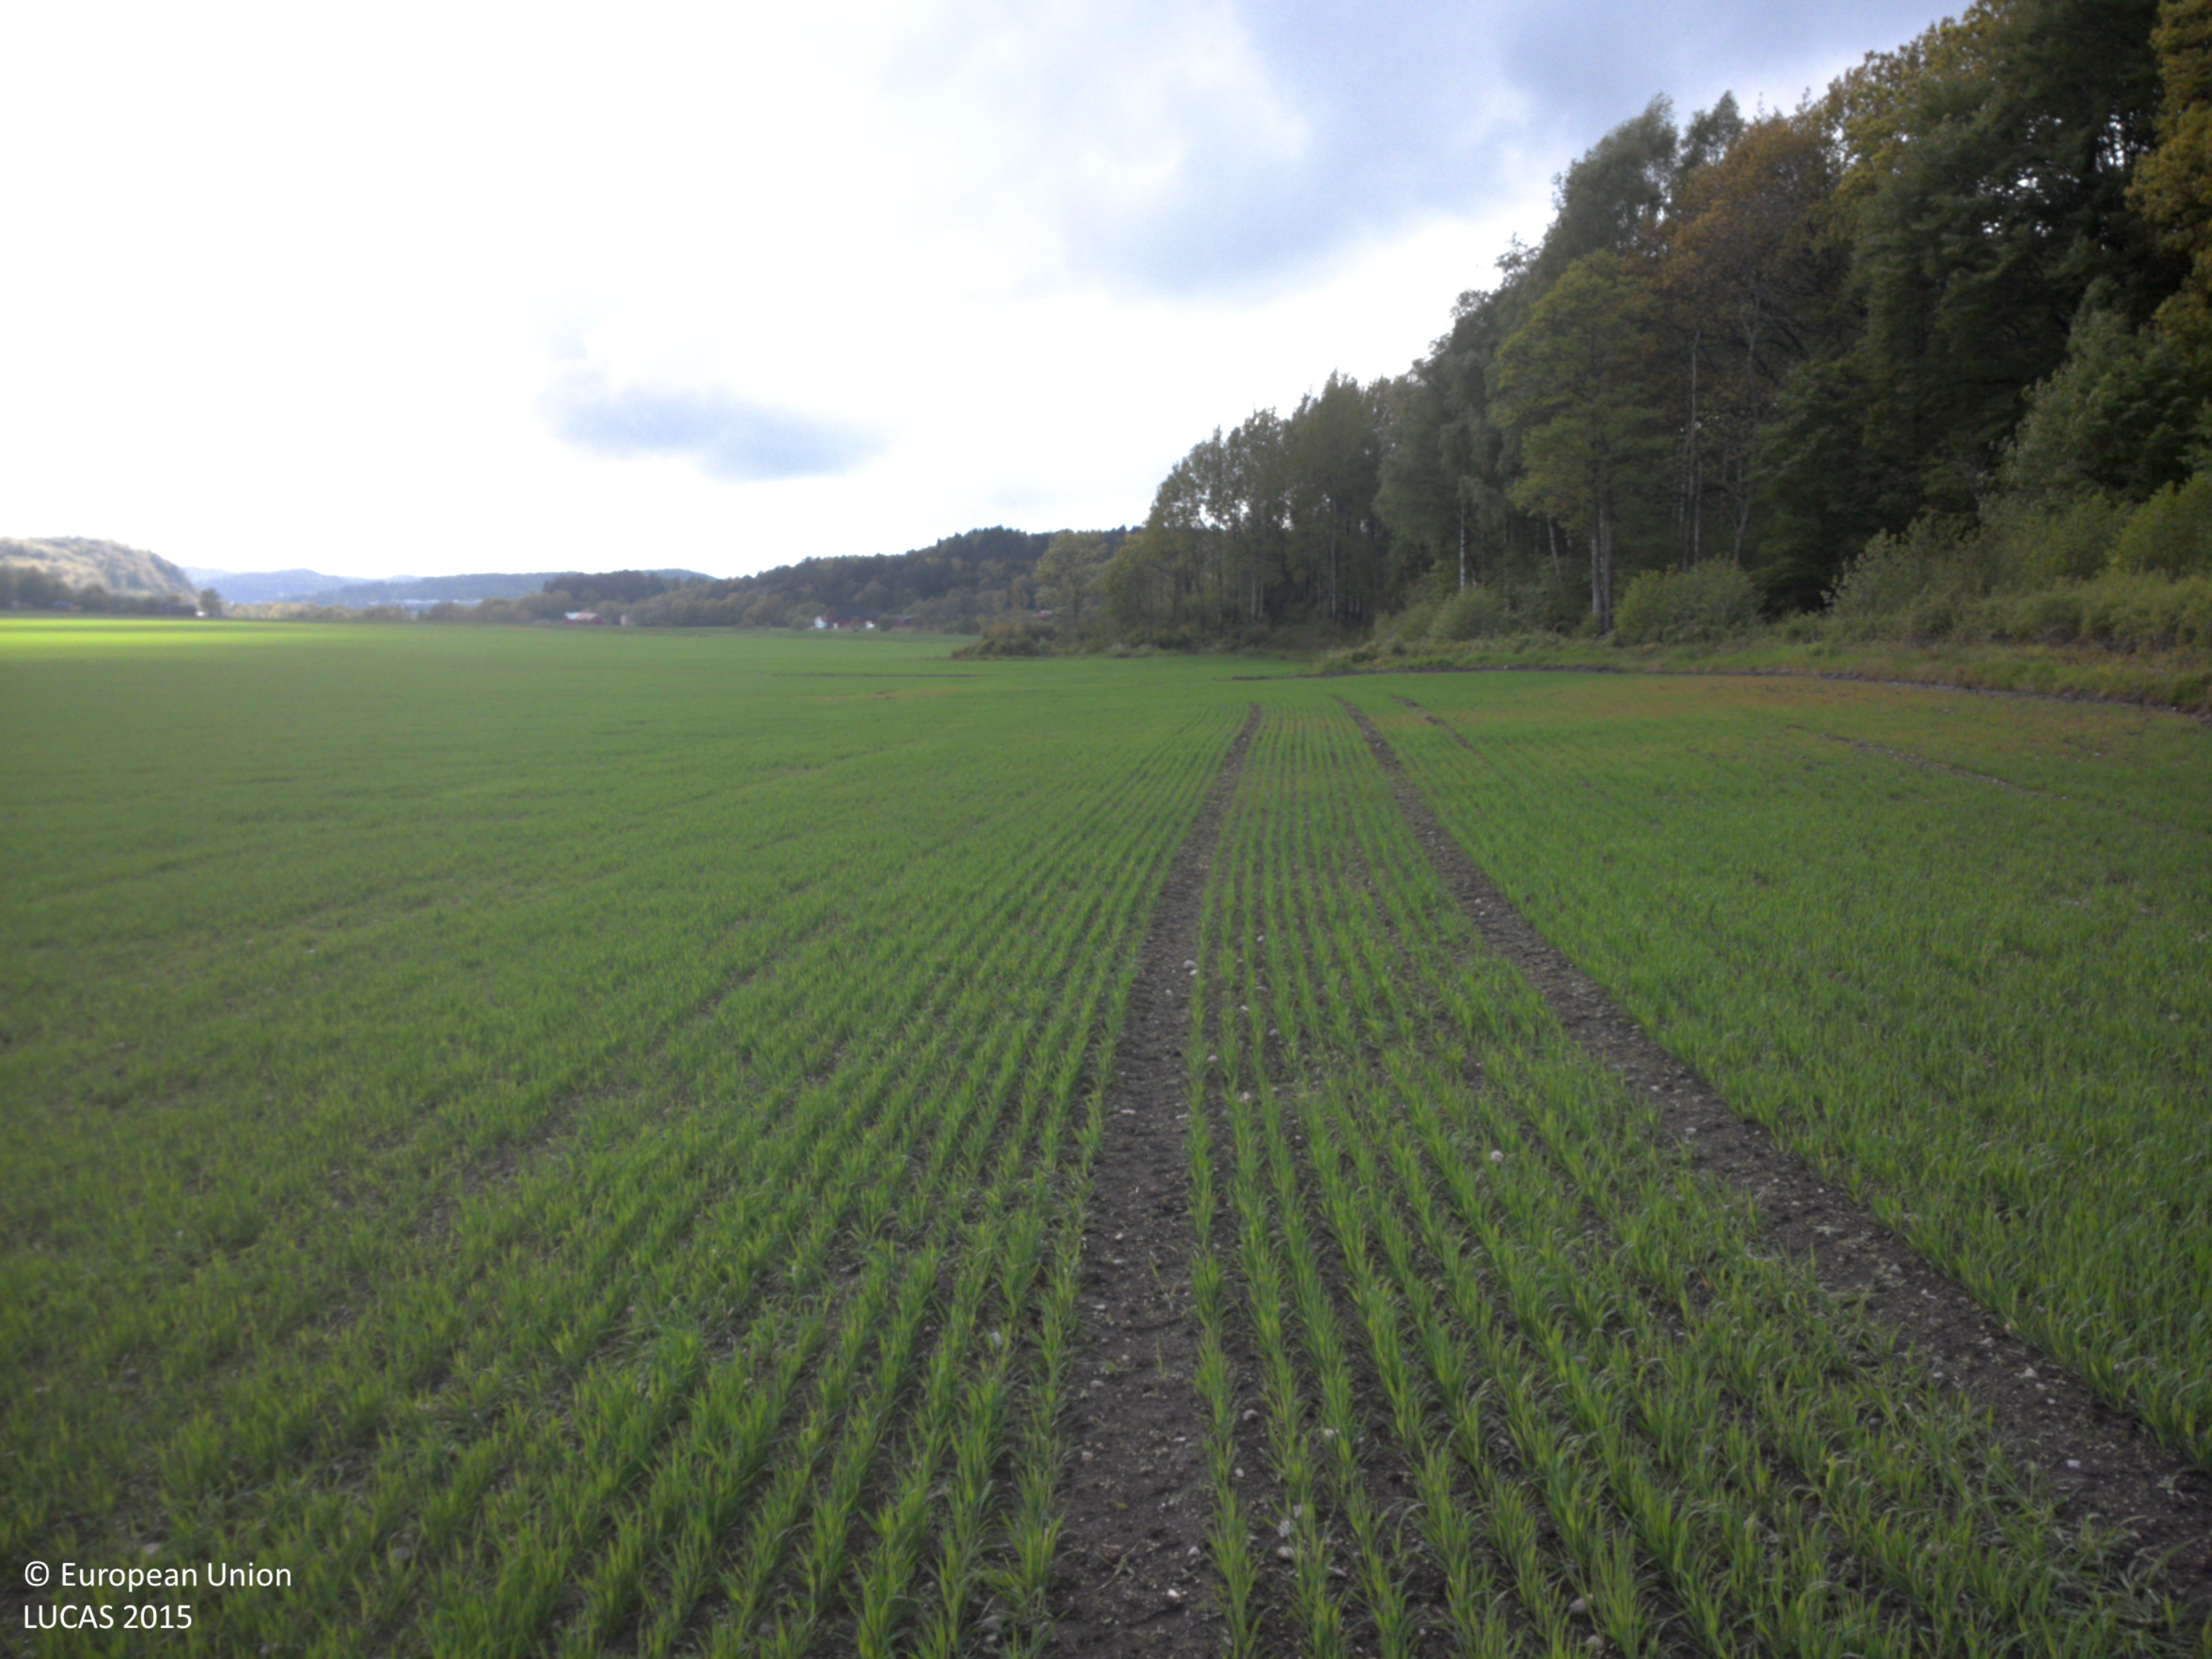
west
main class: Cropland
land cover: Common wheat
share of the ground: 50 - 75 %
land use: Agriculture (excluding fallow land and kitchen gardens)
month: May
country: SE
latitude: 58.3515
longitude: 11.7905
